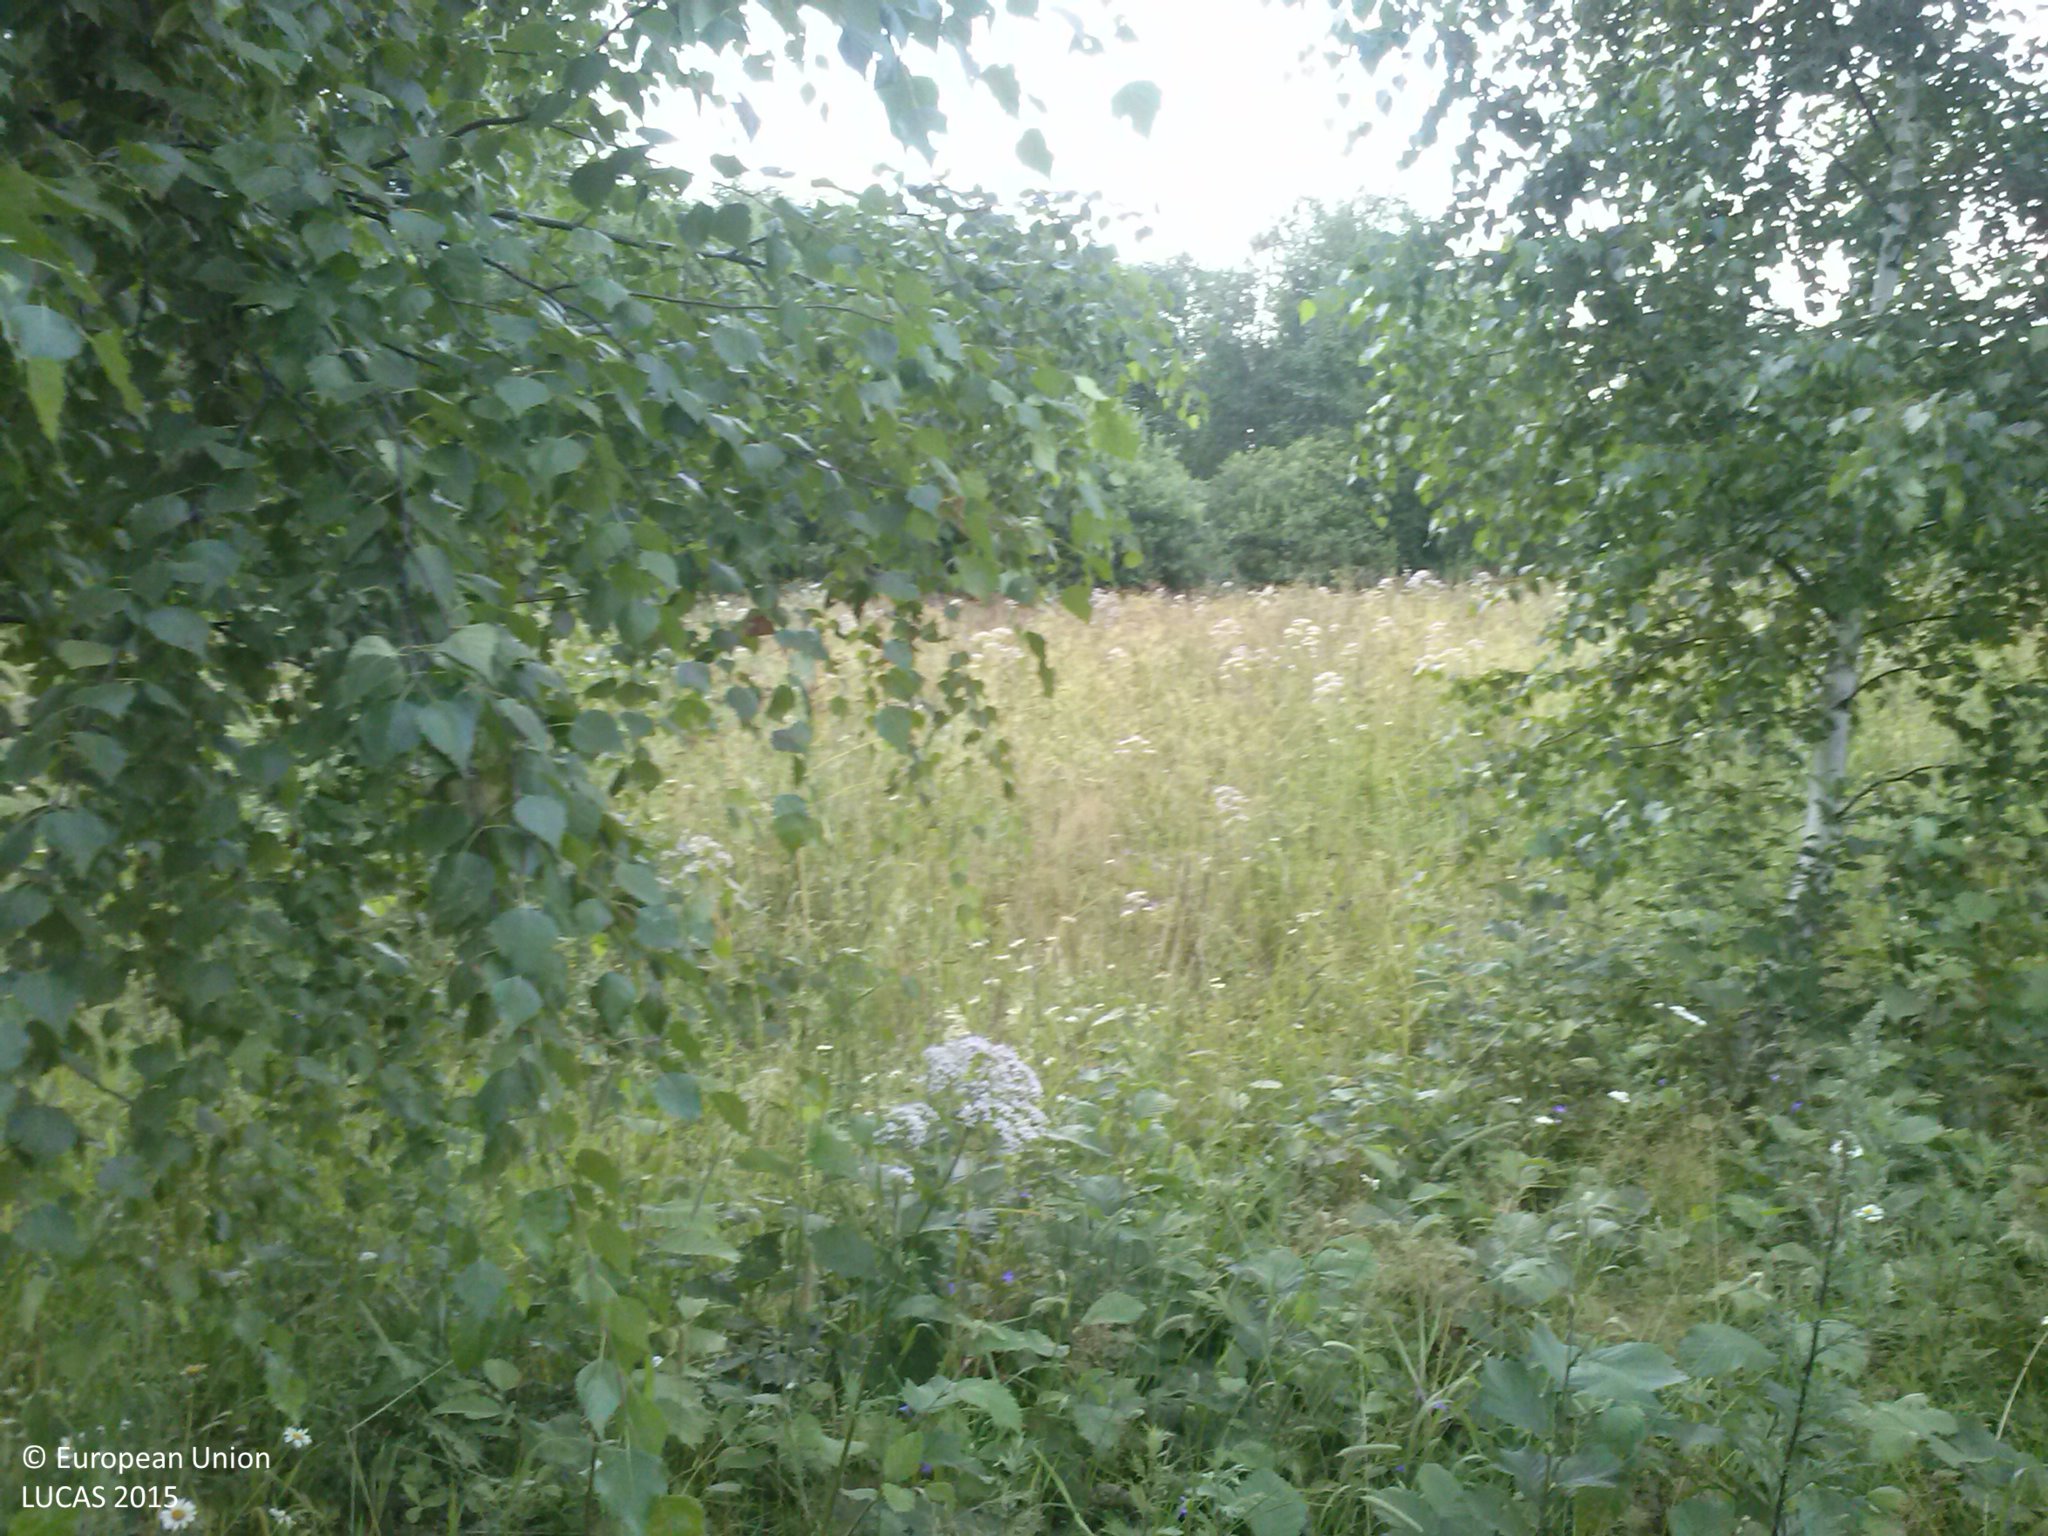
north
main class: Woodland
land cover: Broadleaved woodland
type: non-riverine alder, birch or aspen forest
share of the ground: 50 - 75 %
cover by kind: broadleaved forest trees 60 %, herbaceous plants 30 %
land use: Forestry
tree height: > 5 m
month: July
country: LV
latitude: 56.6694
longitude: 27.0870
